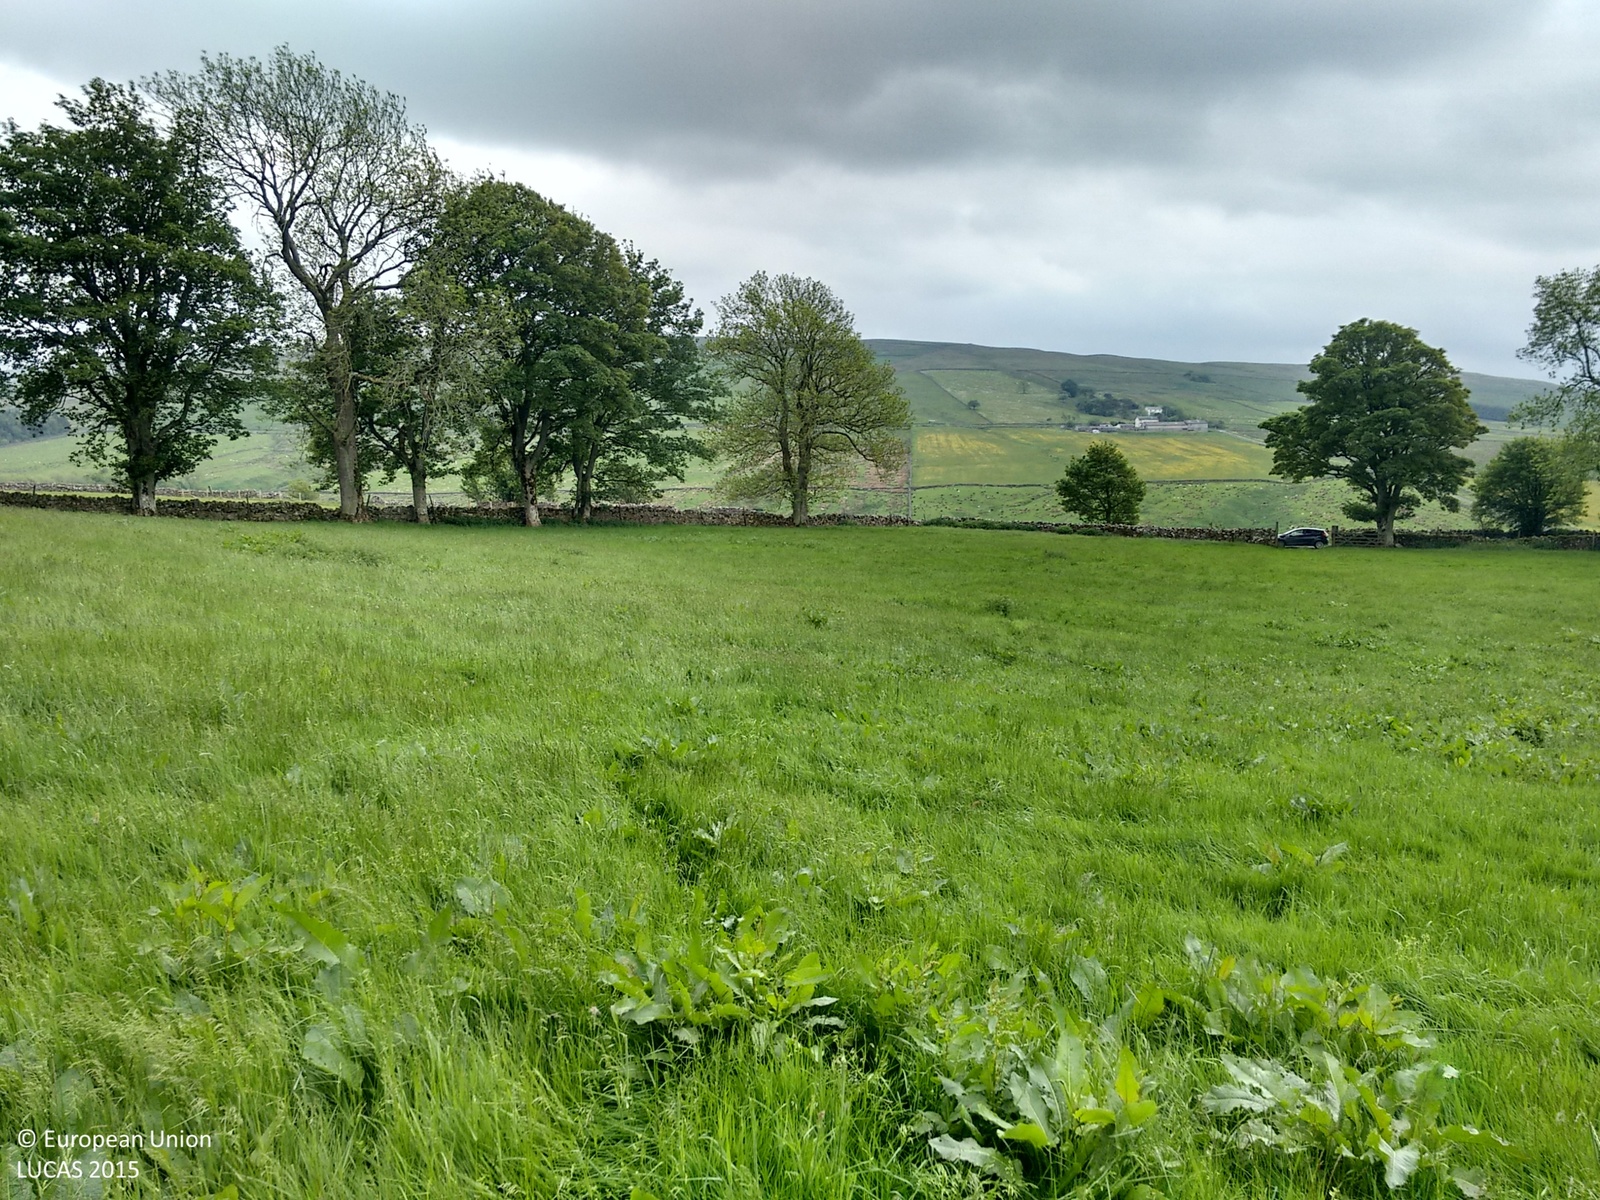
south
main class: Grassland
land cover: Grassland without tree/shrub cover
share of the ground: > 75 %
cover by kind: herbaceous plants 100 %
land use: Agriculture (excluding fallow land and kitchen gardens)
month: June
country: GB
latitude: 54.8183
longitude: -2.4026
